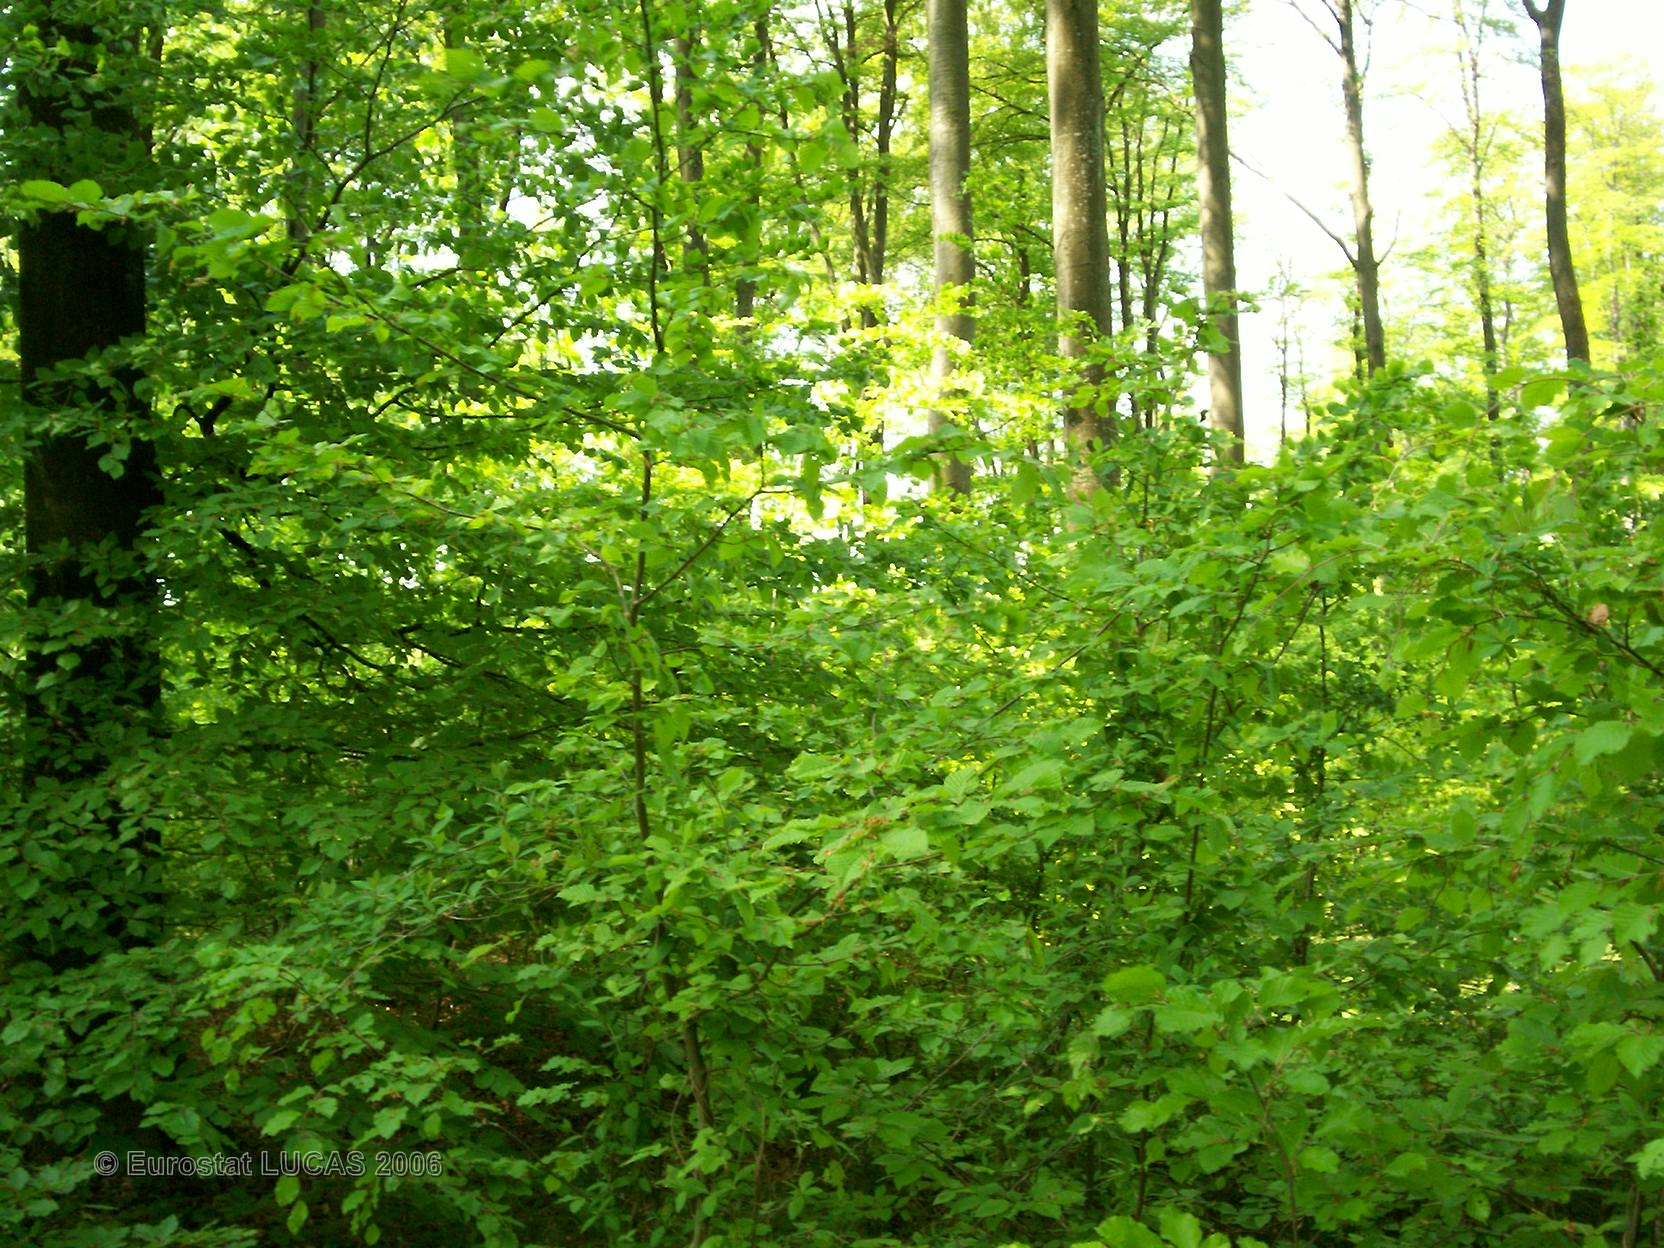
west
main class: Woodland
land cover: Broadleaved forest
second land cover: Grassland with sparse tree/shrub cover
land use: Forestry
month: May
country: FR
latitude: 47.7002
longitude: 7.1365
